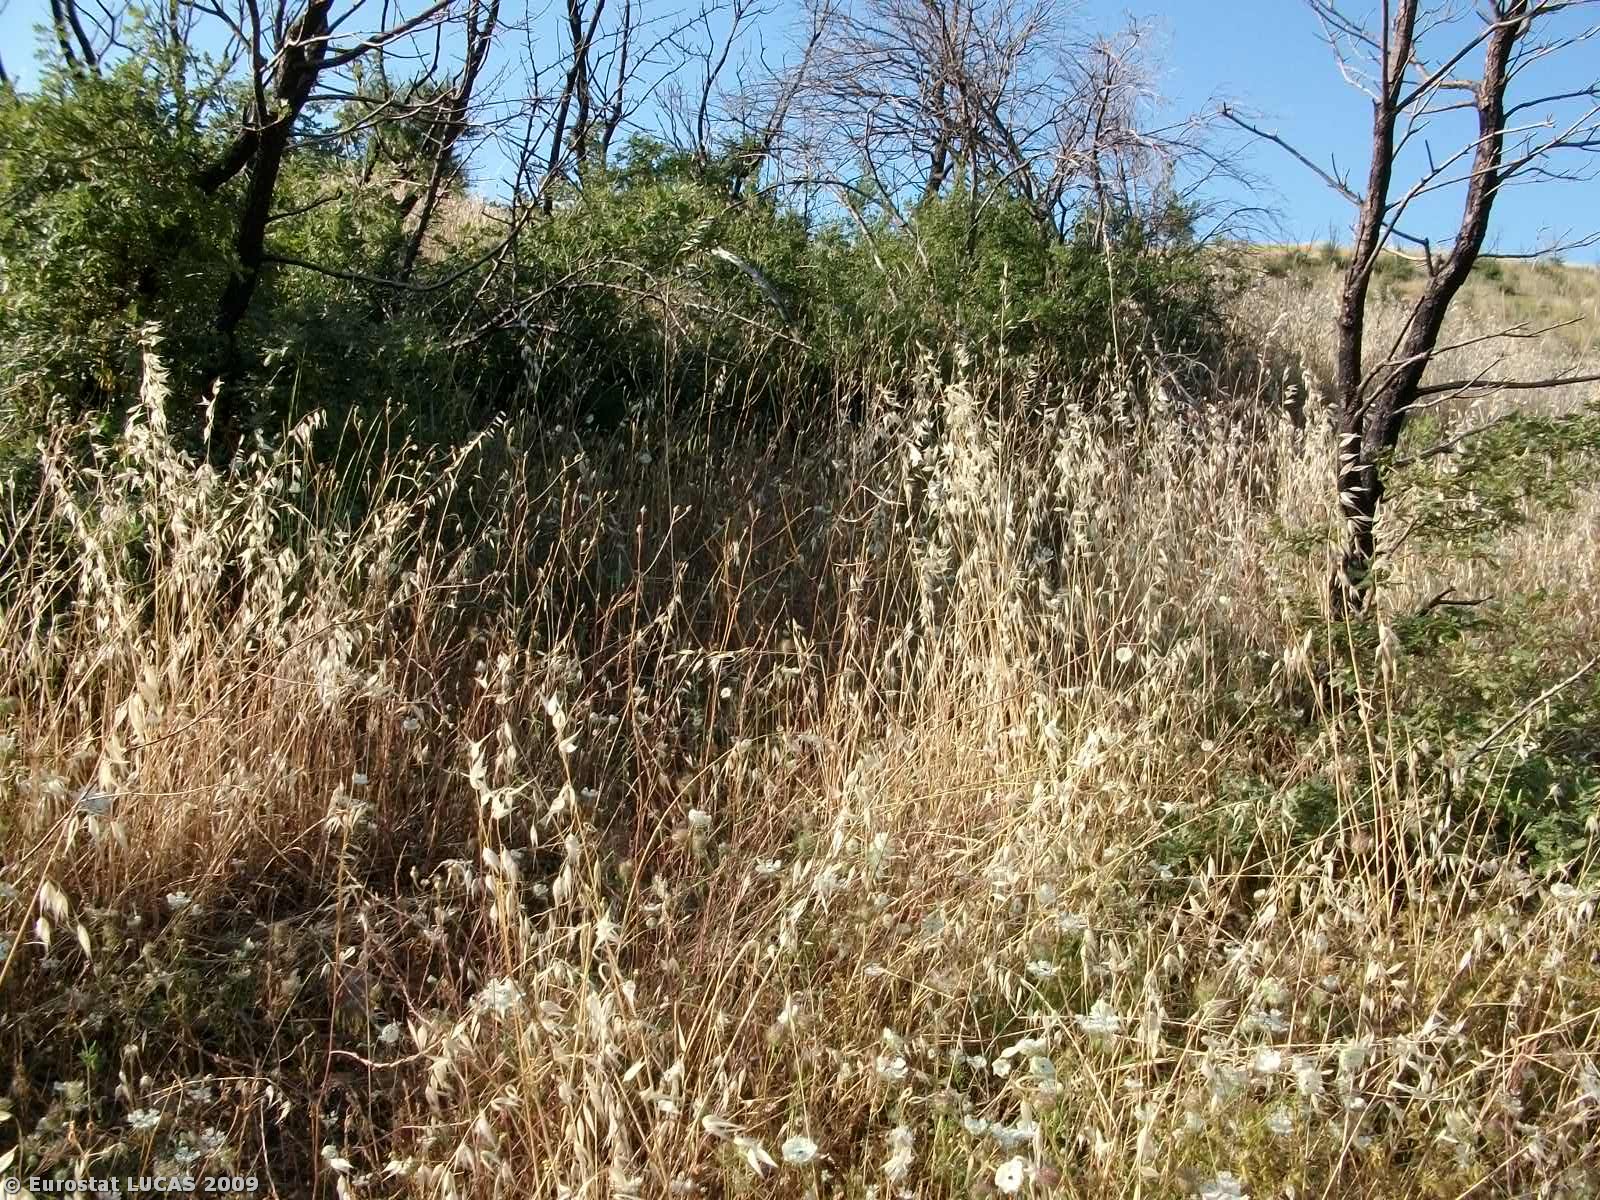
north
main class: Woodland
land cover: Broadleaved woodland
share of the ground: 50 - 75 %
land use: Forestry
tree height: < 5 m
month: June
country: GR
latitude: 37.2920
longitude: 22.1741
